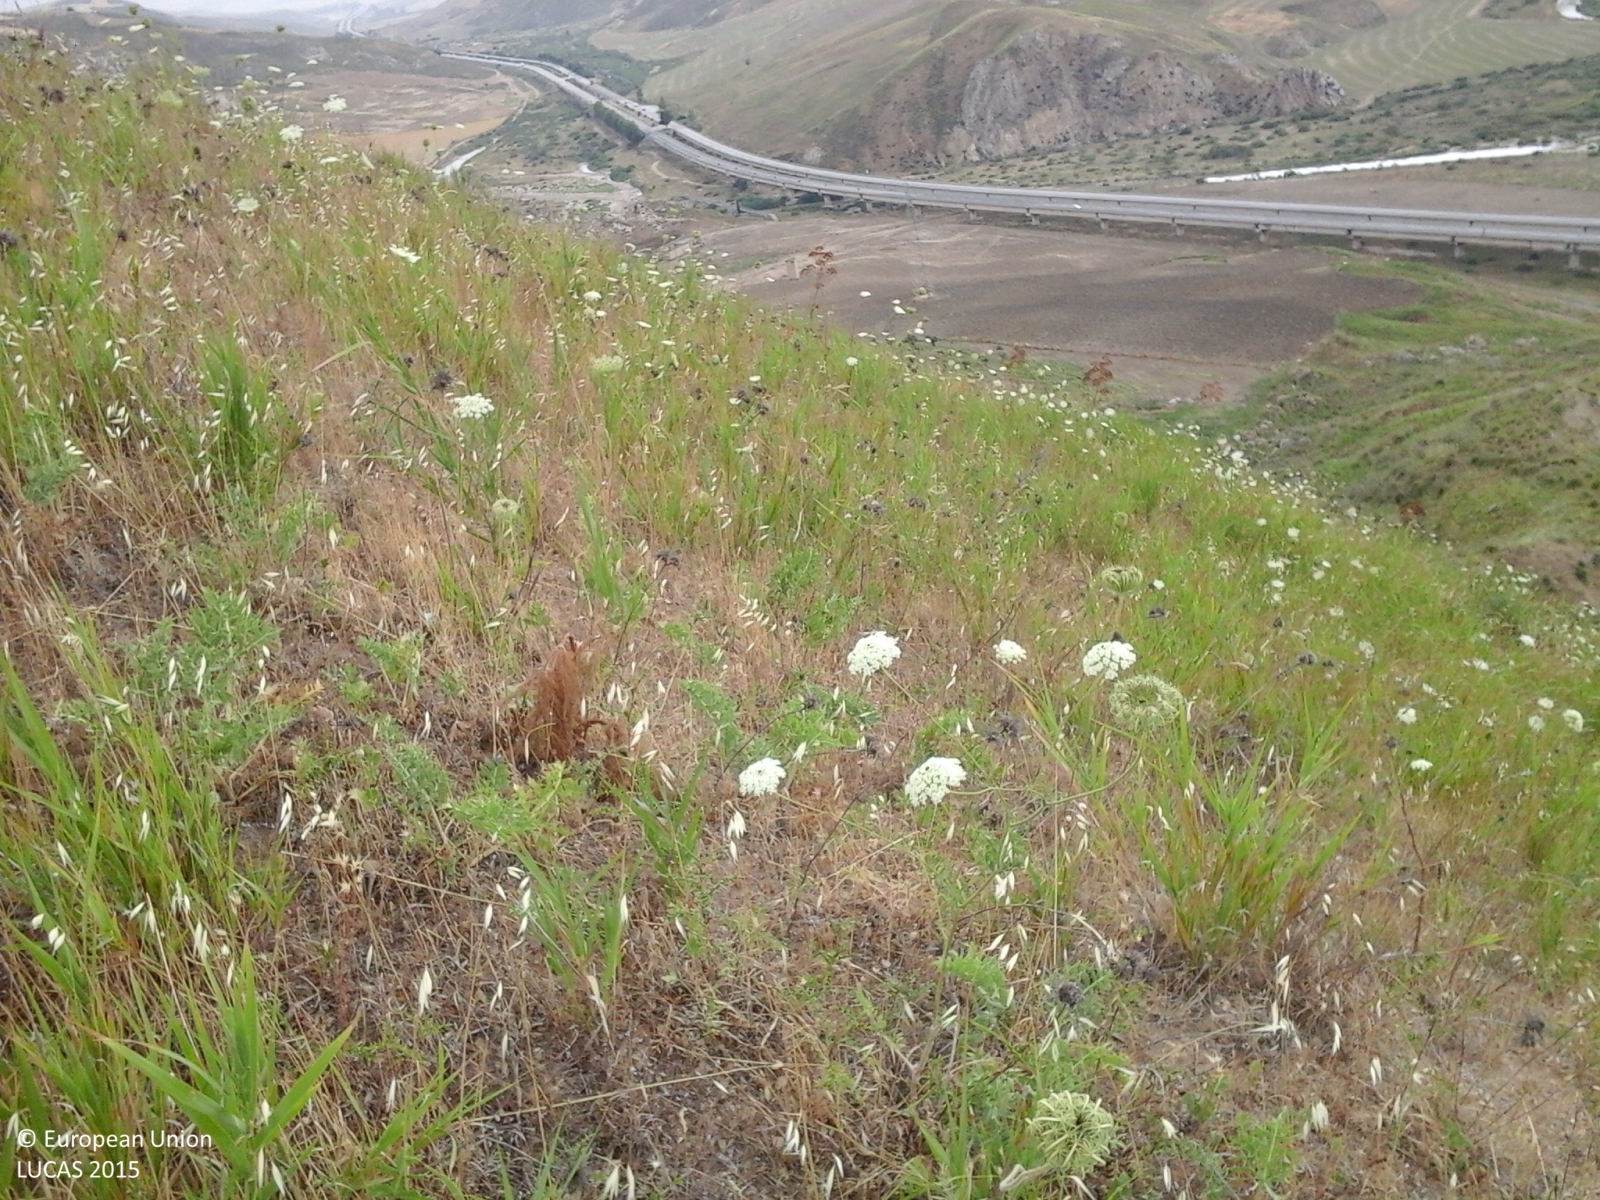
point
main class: Grassland
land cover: Grassland without tree/shrub cover
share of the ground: > 75 %
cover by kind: herbaceous plants 70 %, consolidated bare surface 20 %, unconsolidated bare surface 10 %
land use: Agriculture (excluding fallow land and kitchen gardens)
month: June
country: IT
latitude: 37.6034
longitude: 14.1268
